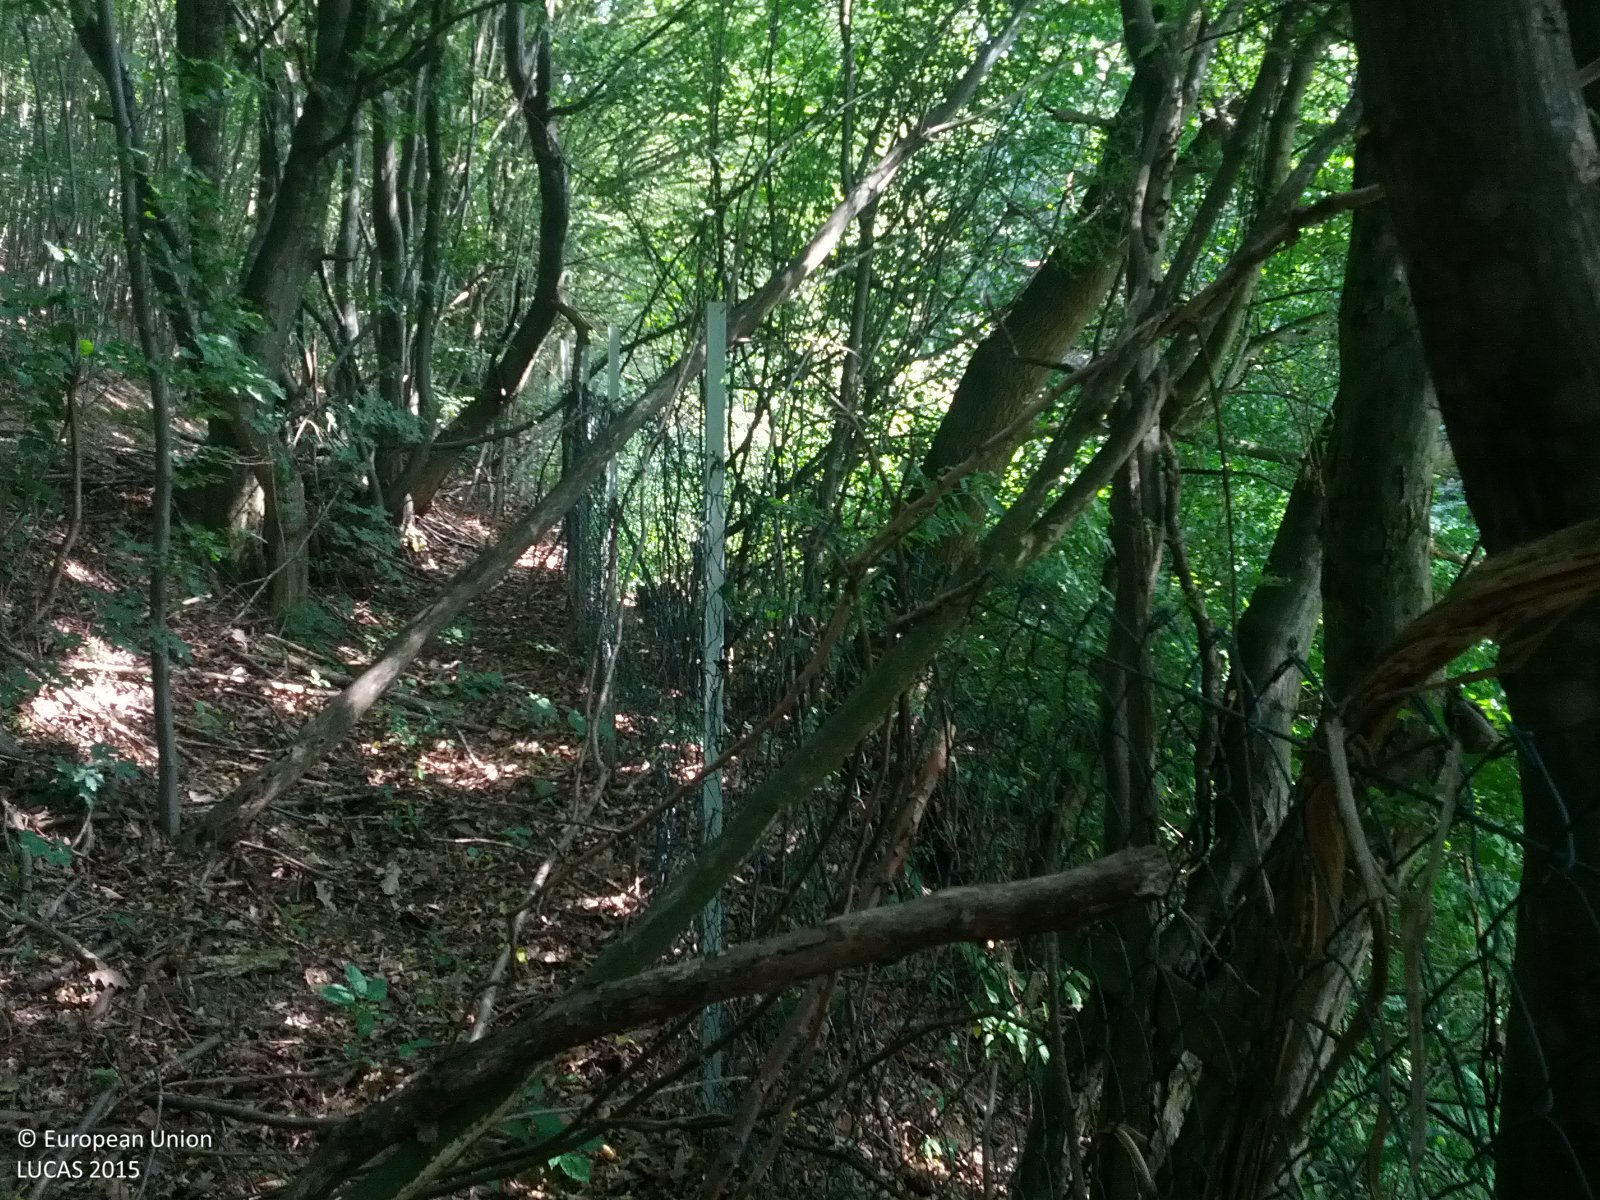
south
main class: Woodland
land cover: Broadleaved woodland
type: beech forest
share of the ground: > 75 %
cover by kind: broadleaved forest trees 100 %
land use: Forestry
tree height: > 5 m
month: June
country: AT
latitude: 48.1617
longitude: 16.1213
